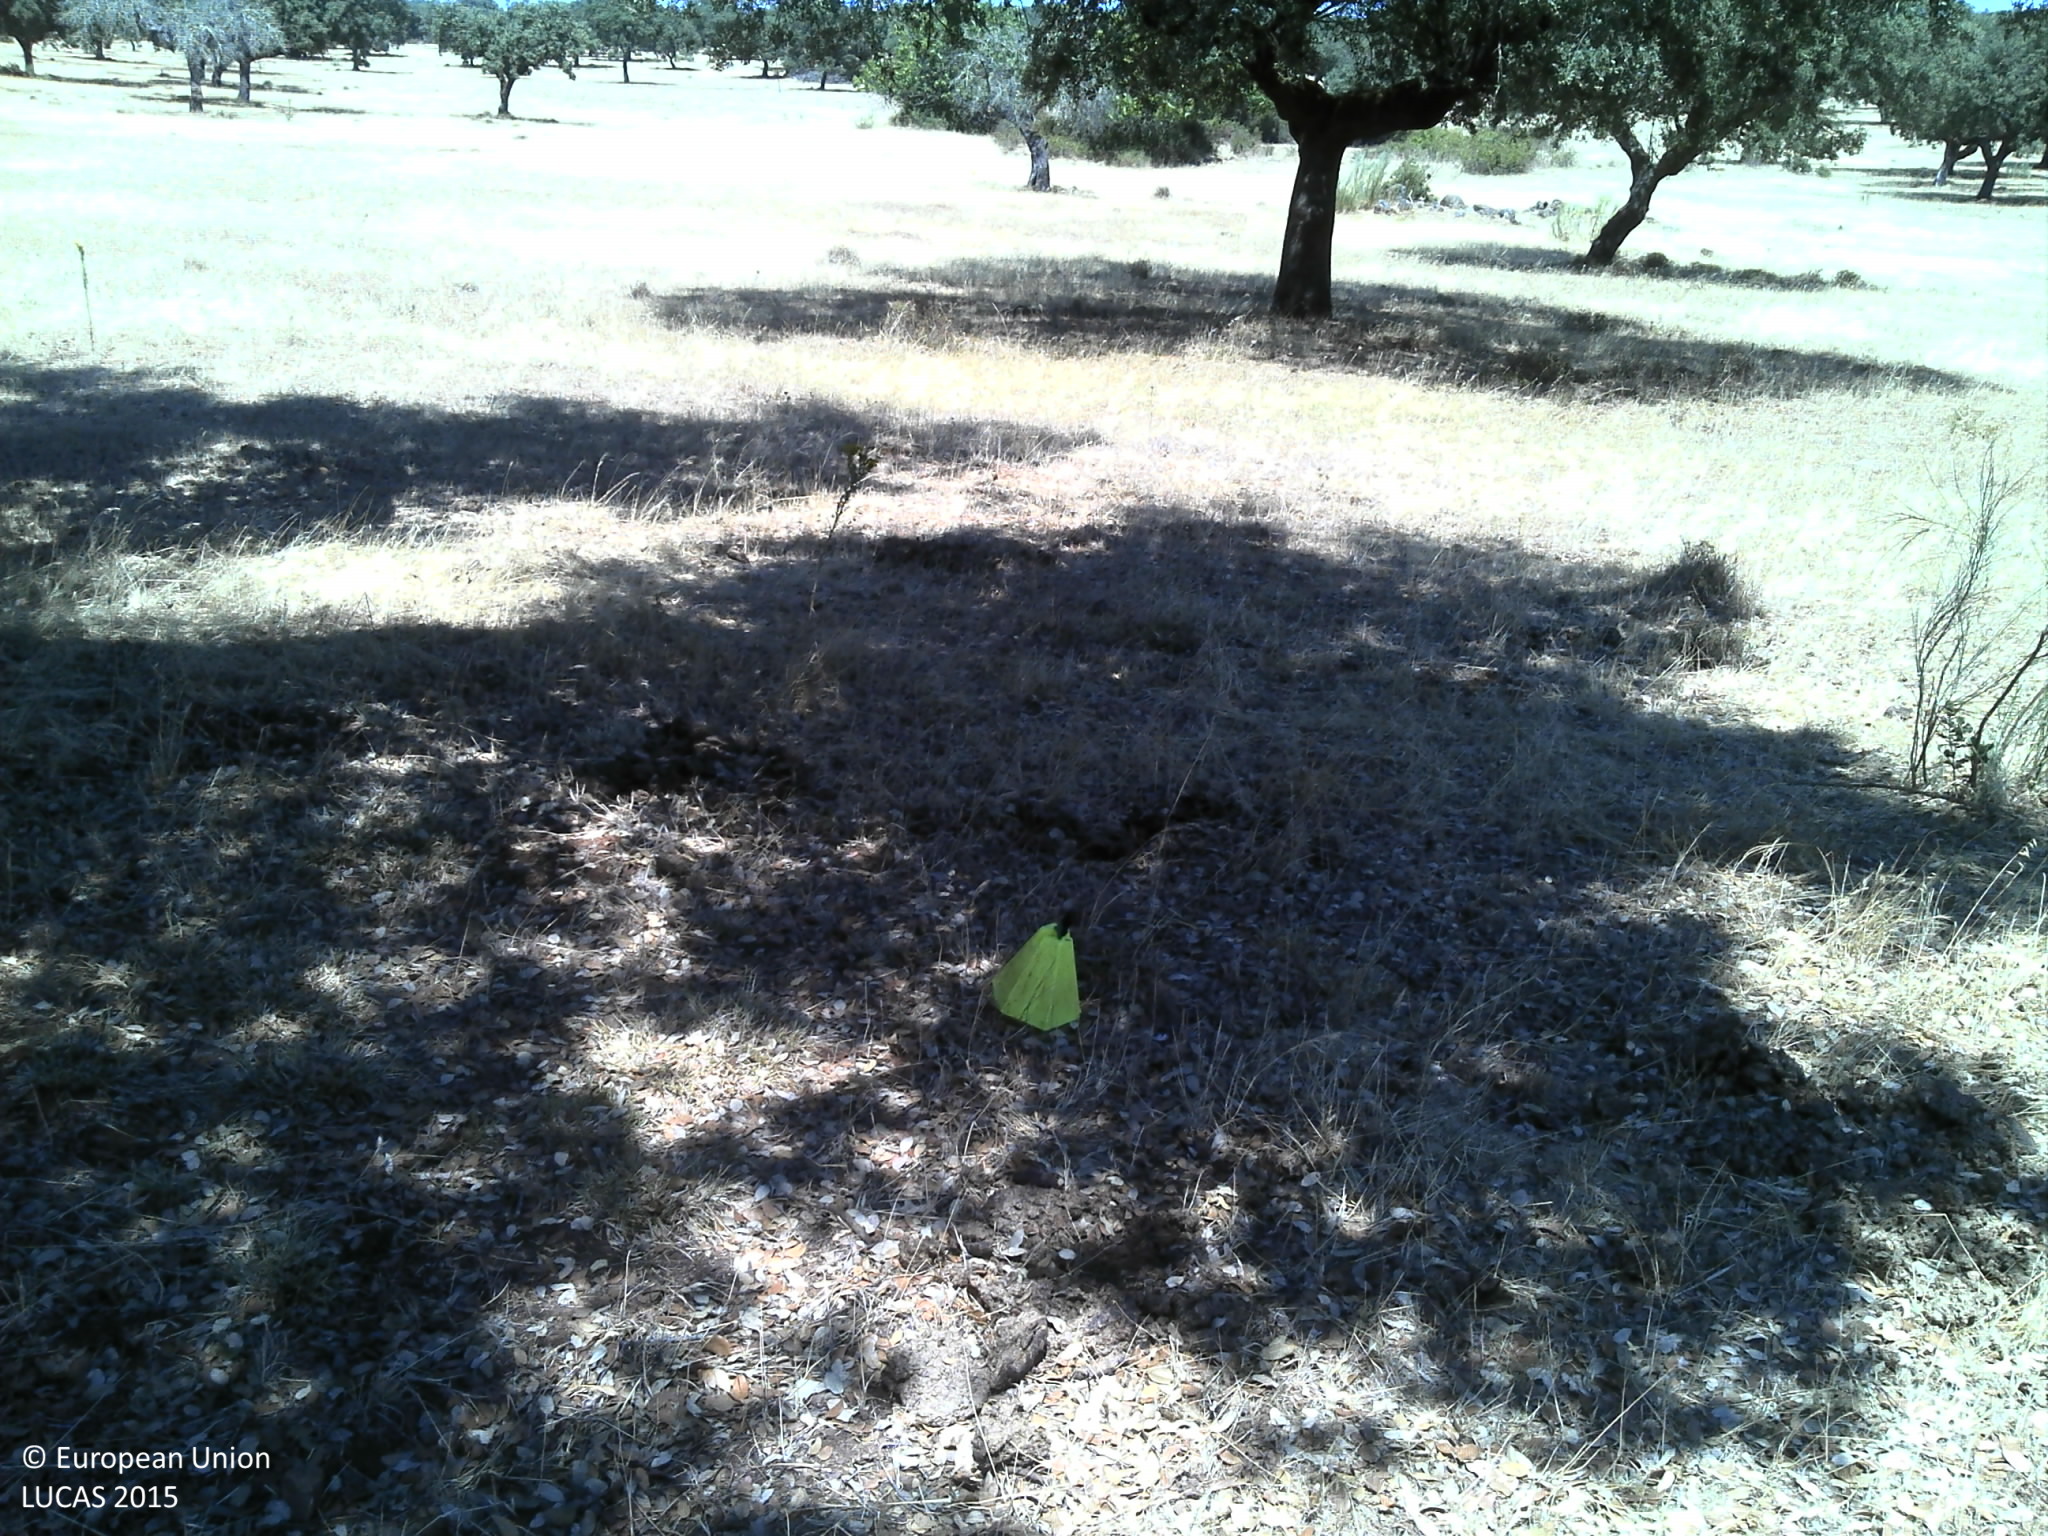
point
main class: Woodland
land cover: Broadleaved woodland
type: broadleaved evergreen forest
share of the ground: 10 - 25 %
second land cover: Grassland without tree/shrub cover
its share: 10 - 25 %
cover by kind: unconsolidated bare surface 70 %, broadleaved forest trees 15 %, herbaceous plants 15 %
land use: Forestry
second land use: Agriculture (excluding fallow land and kitchen gardens)
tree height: > 5 m
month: July
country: PT
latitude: 39.1164
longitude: -7.5397
